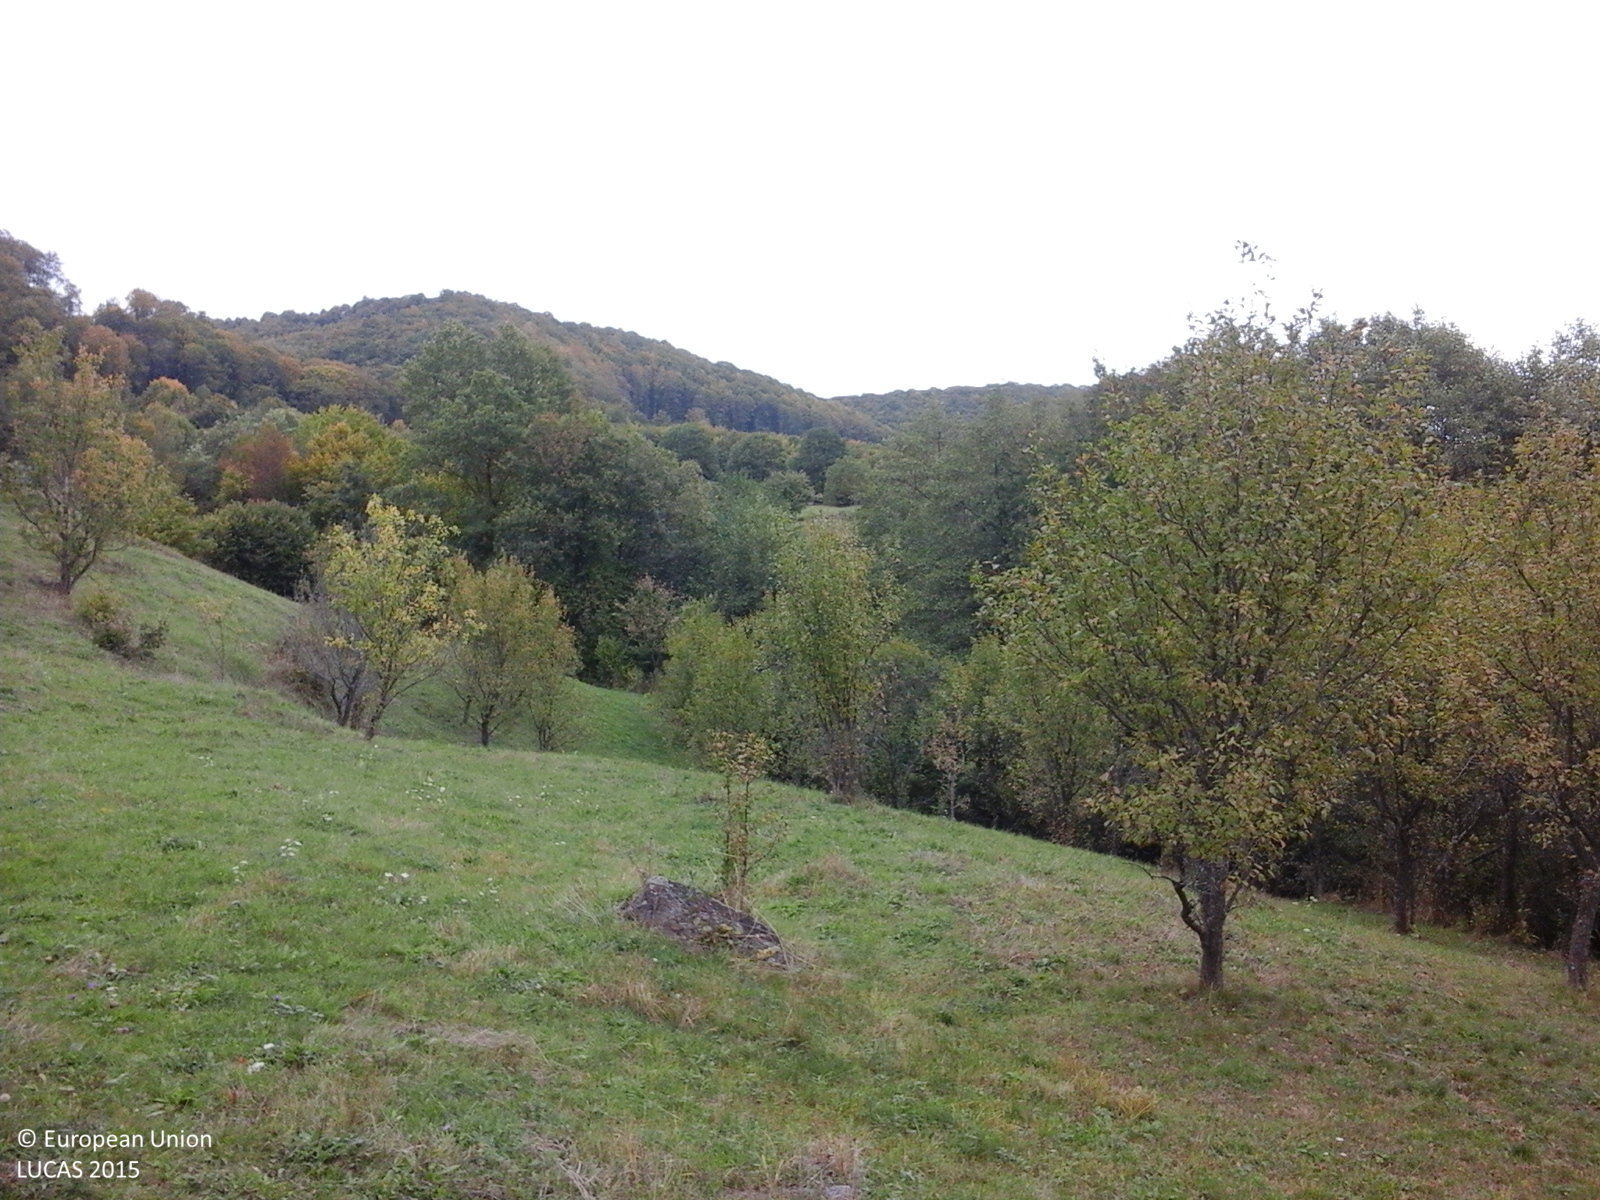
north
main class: Cropland
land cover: Apple fruit
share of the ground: > 75 %
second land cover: Grassland without tree/shrub cover
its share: > 75 %
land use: Agriculture (excluding fallow land and kitchen gardens)
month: October
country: RO
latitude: 46.4130
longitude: 25.3119
